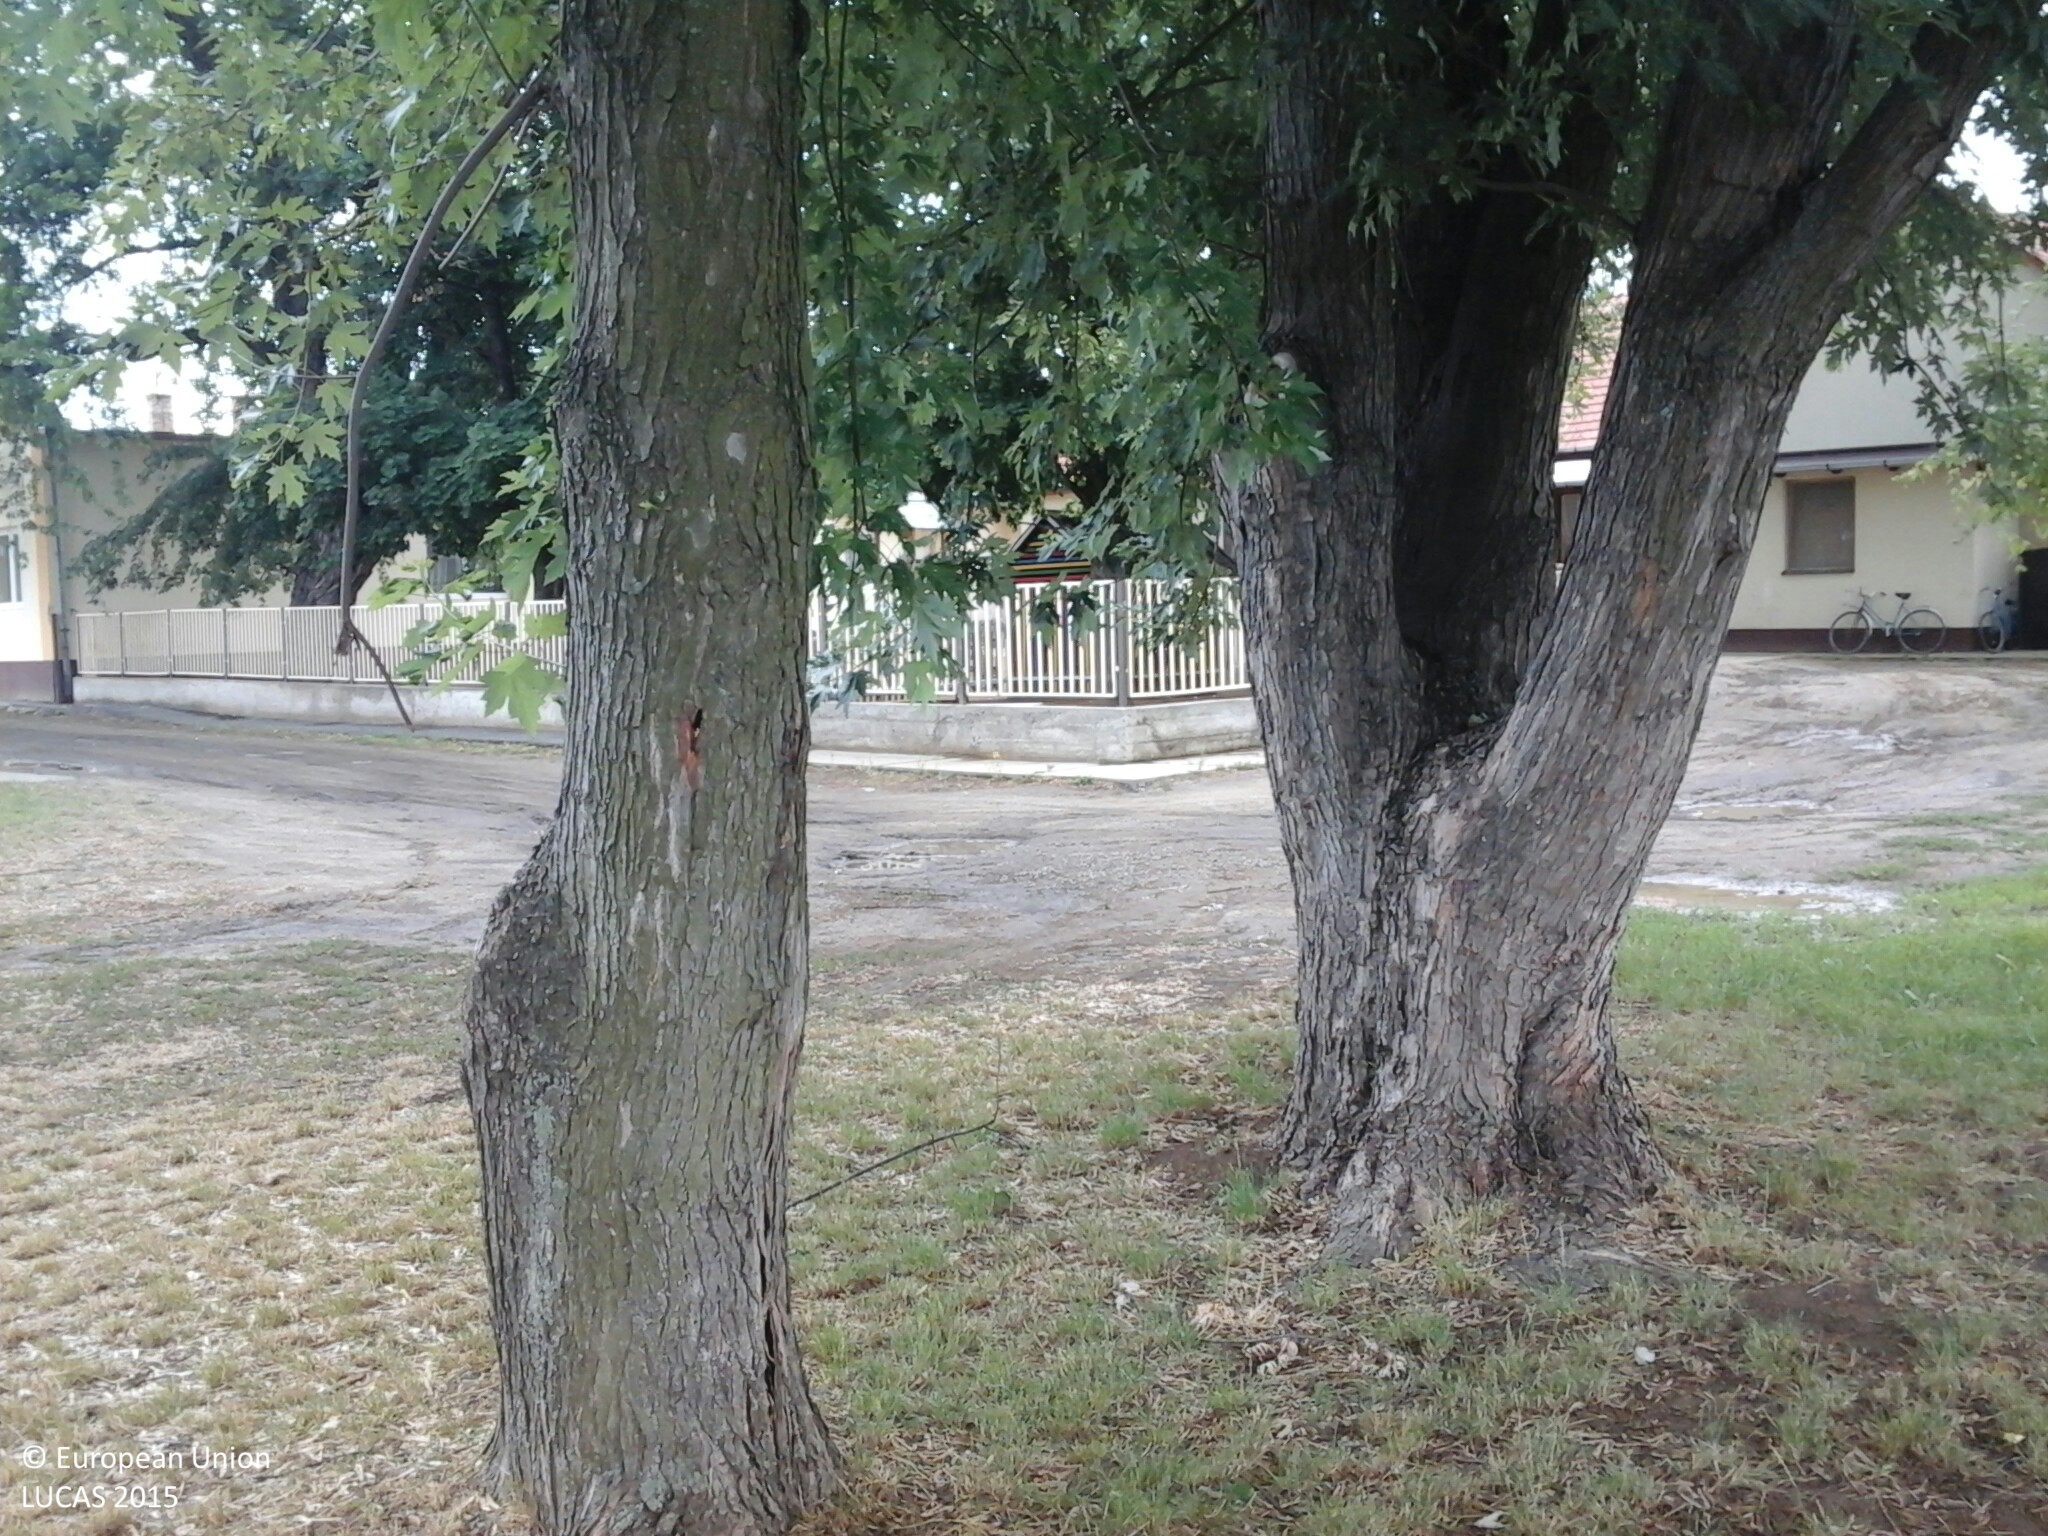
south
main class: Grassland
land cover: Grassland with sparse tree/shrub cover
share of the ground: > 75 %
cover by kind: herbaceous plants 95 %, broadleaved forest trees 5 %
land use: Amenities, museums, leisure
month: July
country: HU
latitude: 48.2005
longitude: 22.1782
